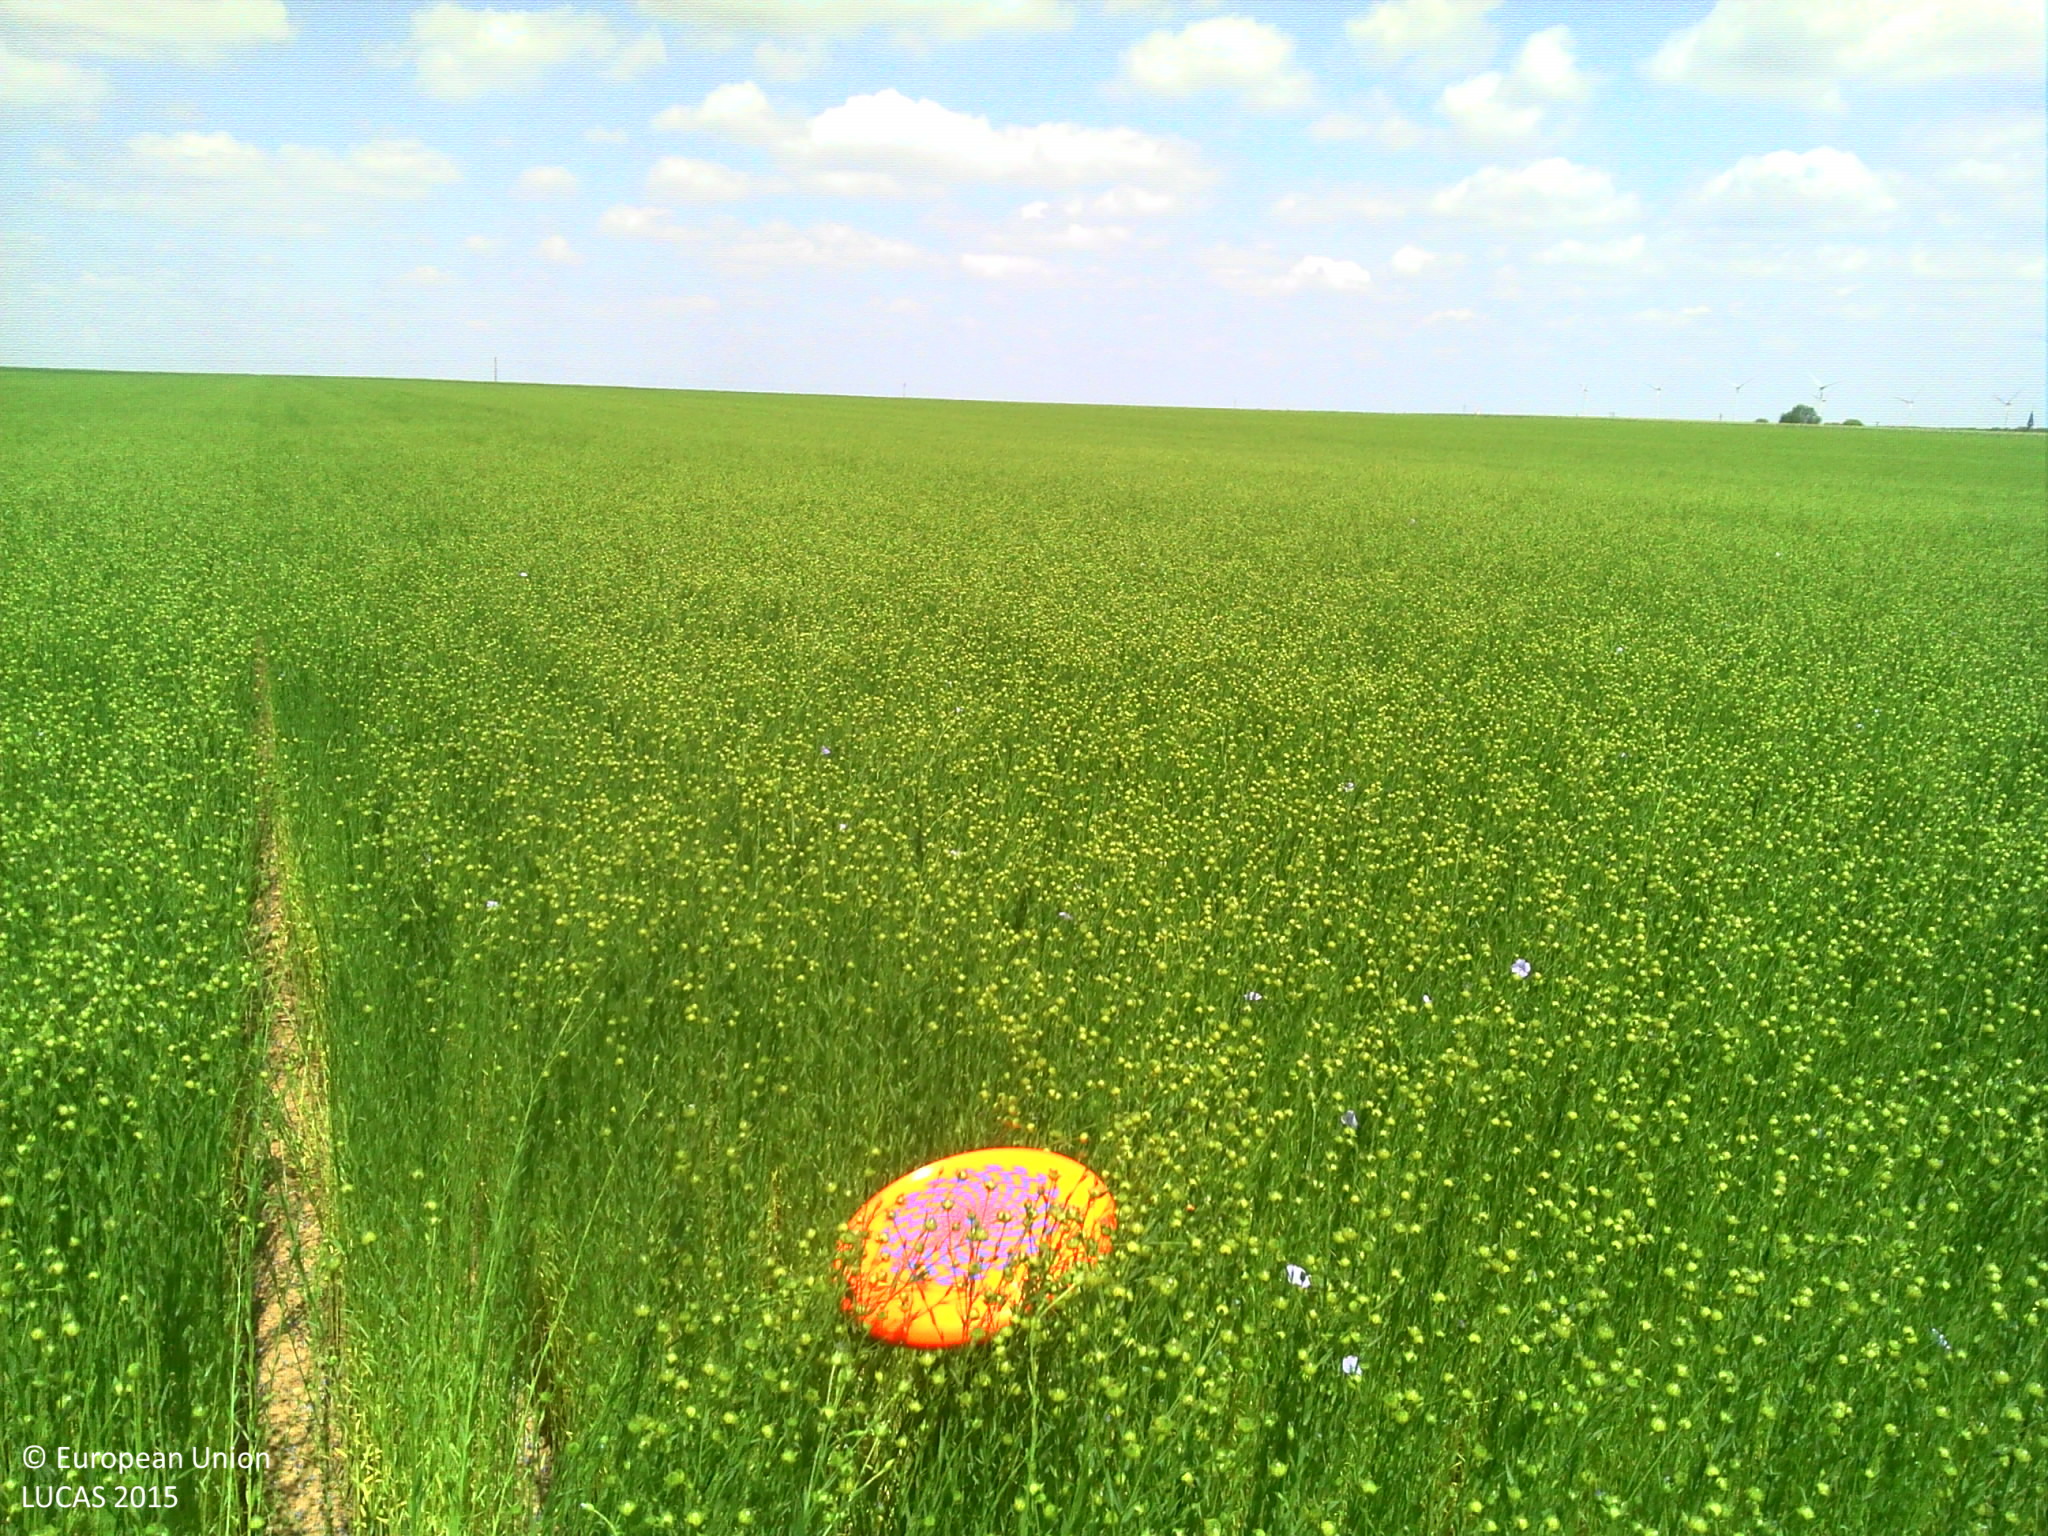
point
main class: Cropland
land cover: Other fibre and oleaginous crops
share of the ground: > 75 %
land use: Agriculture (excluding fallow land and kitchen gardens)
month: June
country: FR
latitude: 49.6835
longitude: 2.4895
